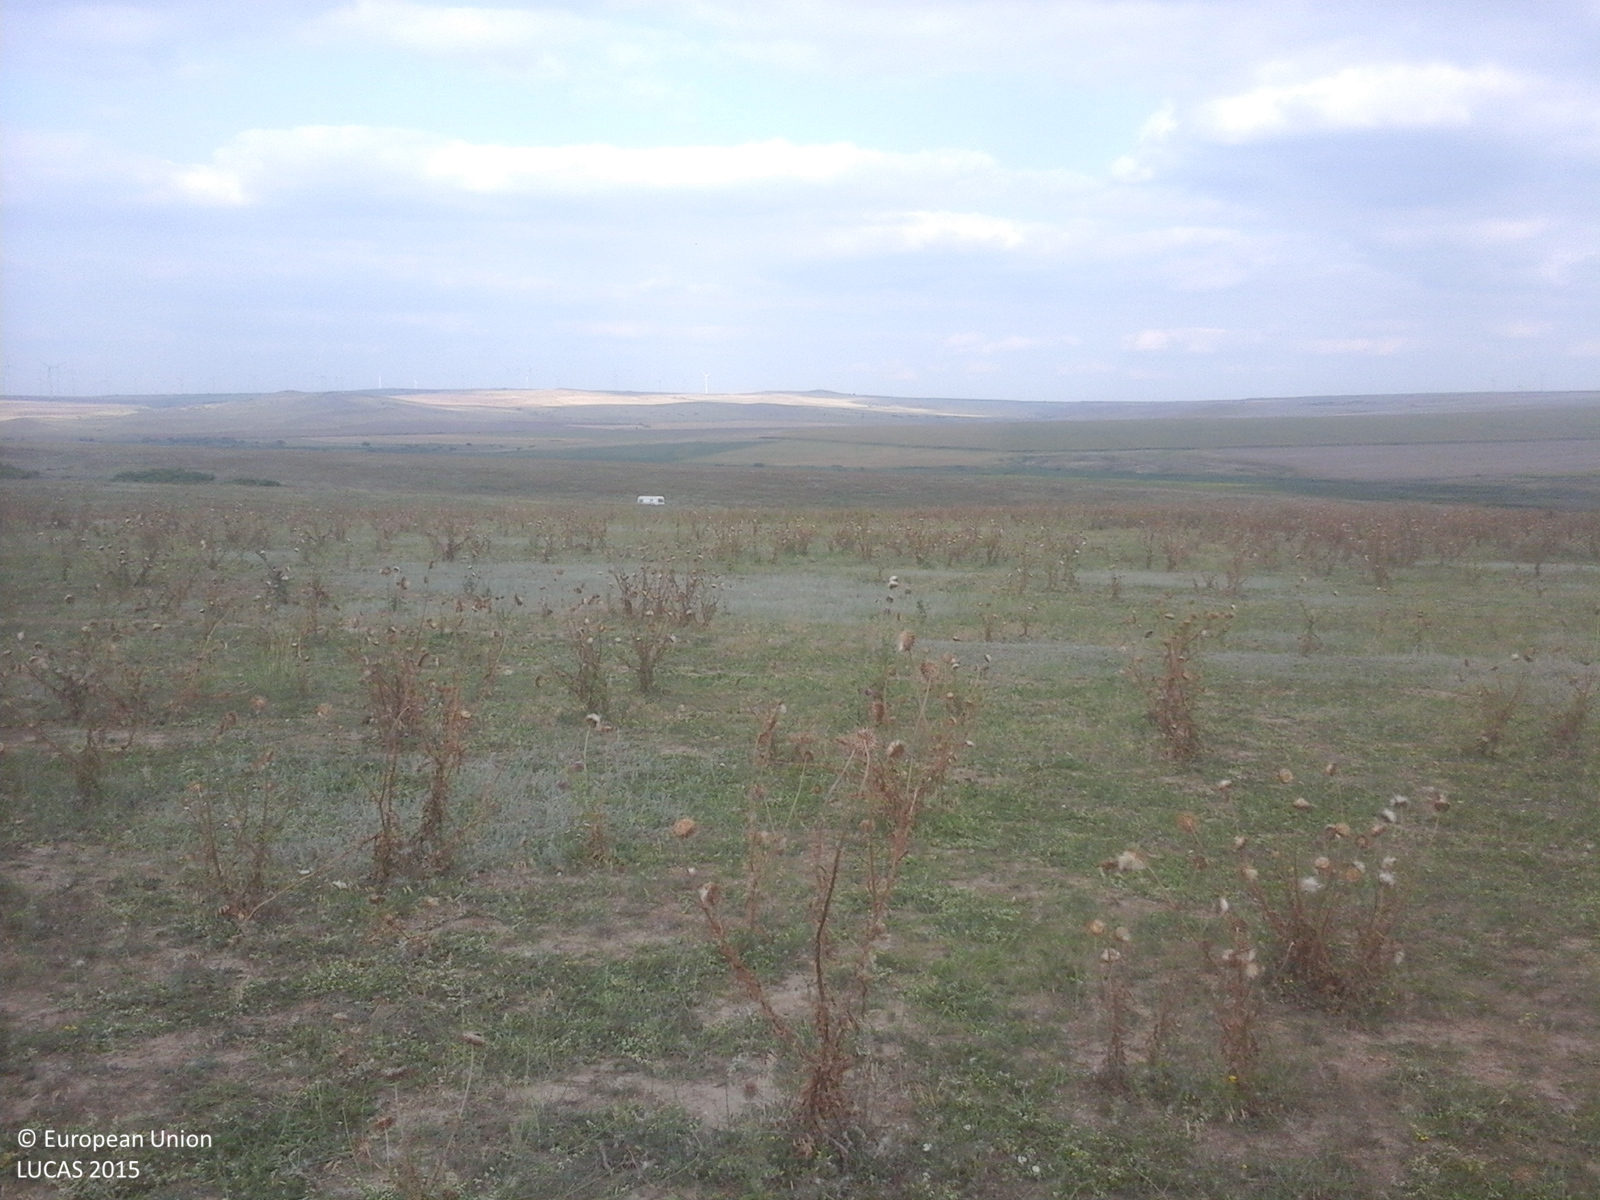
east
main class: Grassland
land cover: Spontaneously vegetated surfaces
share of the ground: > 75 %
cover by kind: herbaceous plants 100 %
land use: Fallow land
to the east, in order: Spontaneously vegetated surfaces; Ditches and canals
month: August
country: RO
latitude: 44.7466
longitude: 28.2423
